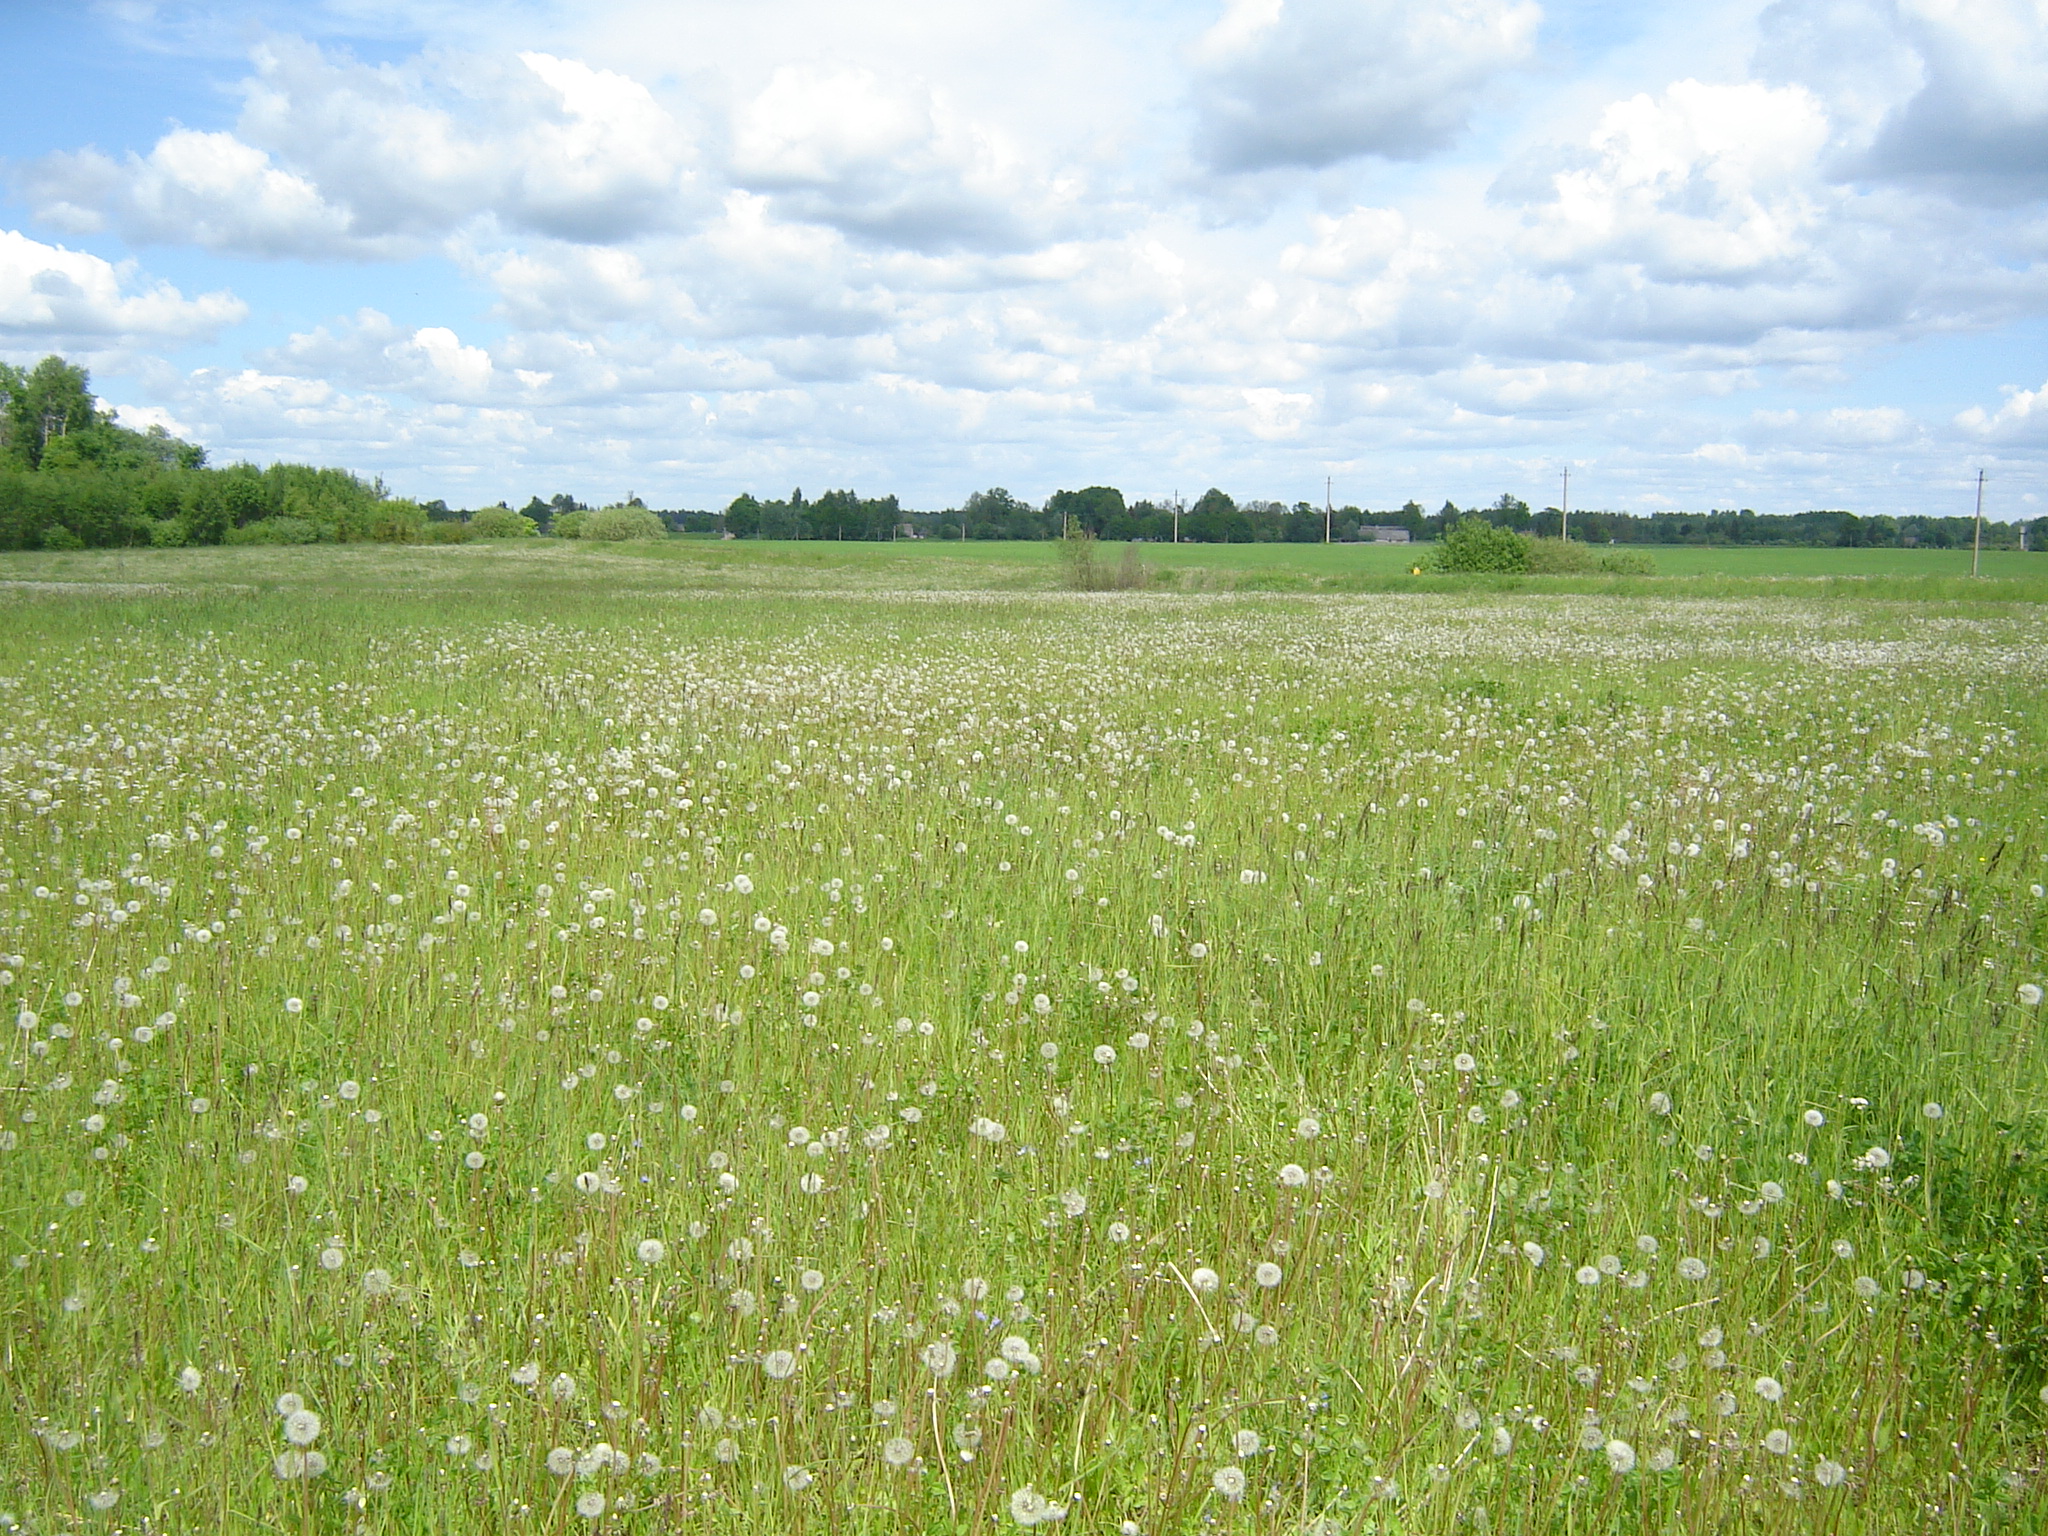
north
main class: Grassland
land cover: Grassland without tree/shrub cover
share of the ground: > 75 %
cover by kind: herbaceous plants 100 %
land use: Agriculture (excluding fallow land and kitchen gardens)
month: May
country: LT
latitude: 55.8246
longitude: 25.2000
